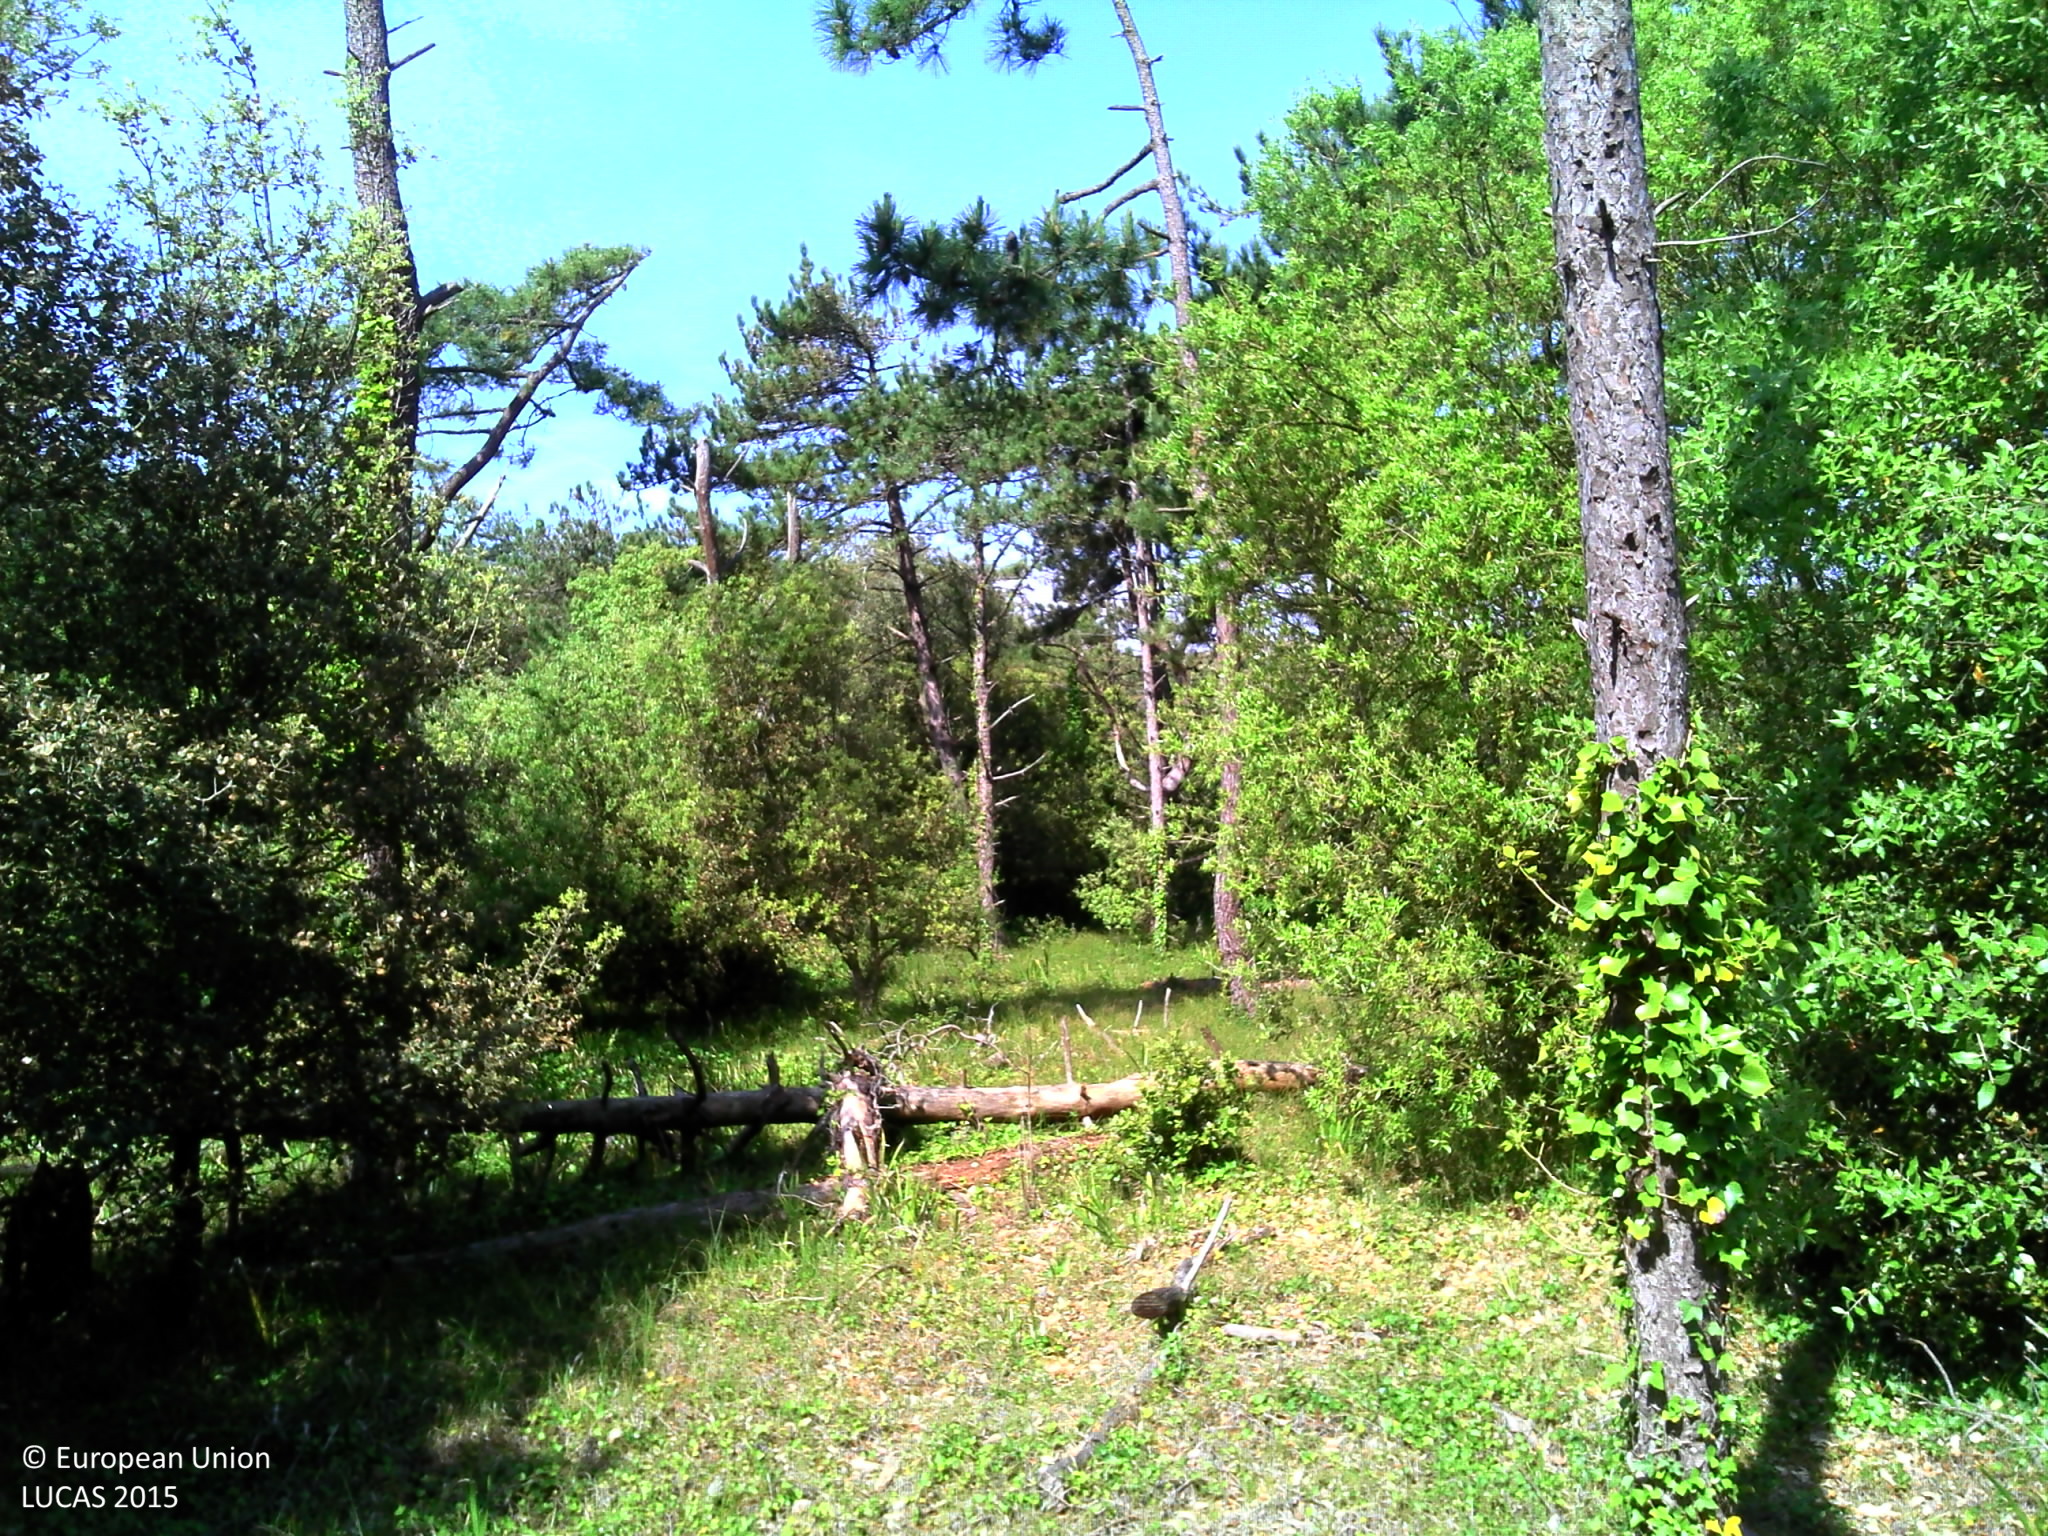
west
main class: Woodland
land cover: Pine dominated mixed woodland
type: coniferous forest of the mediterranean region
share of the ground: > 75 %
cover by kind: coniferous forest trees 75 %, broadleaved forest trees 25 %
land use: Forestry
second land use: Agriculture (excluding fallow land and kitchen gardens)
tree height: > 5 m
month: May
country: FR
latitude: 46.2542
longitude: -1.5169
